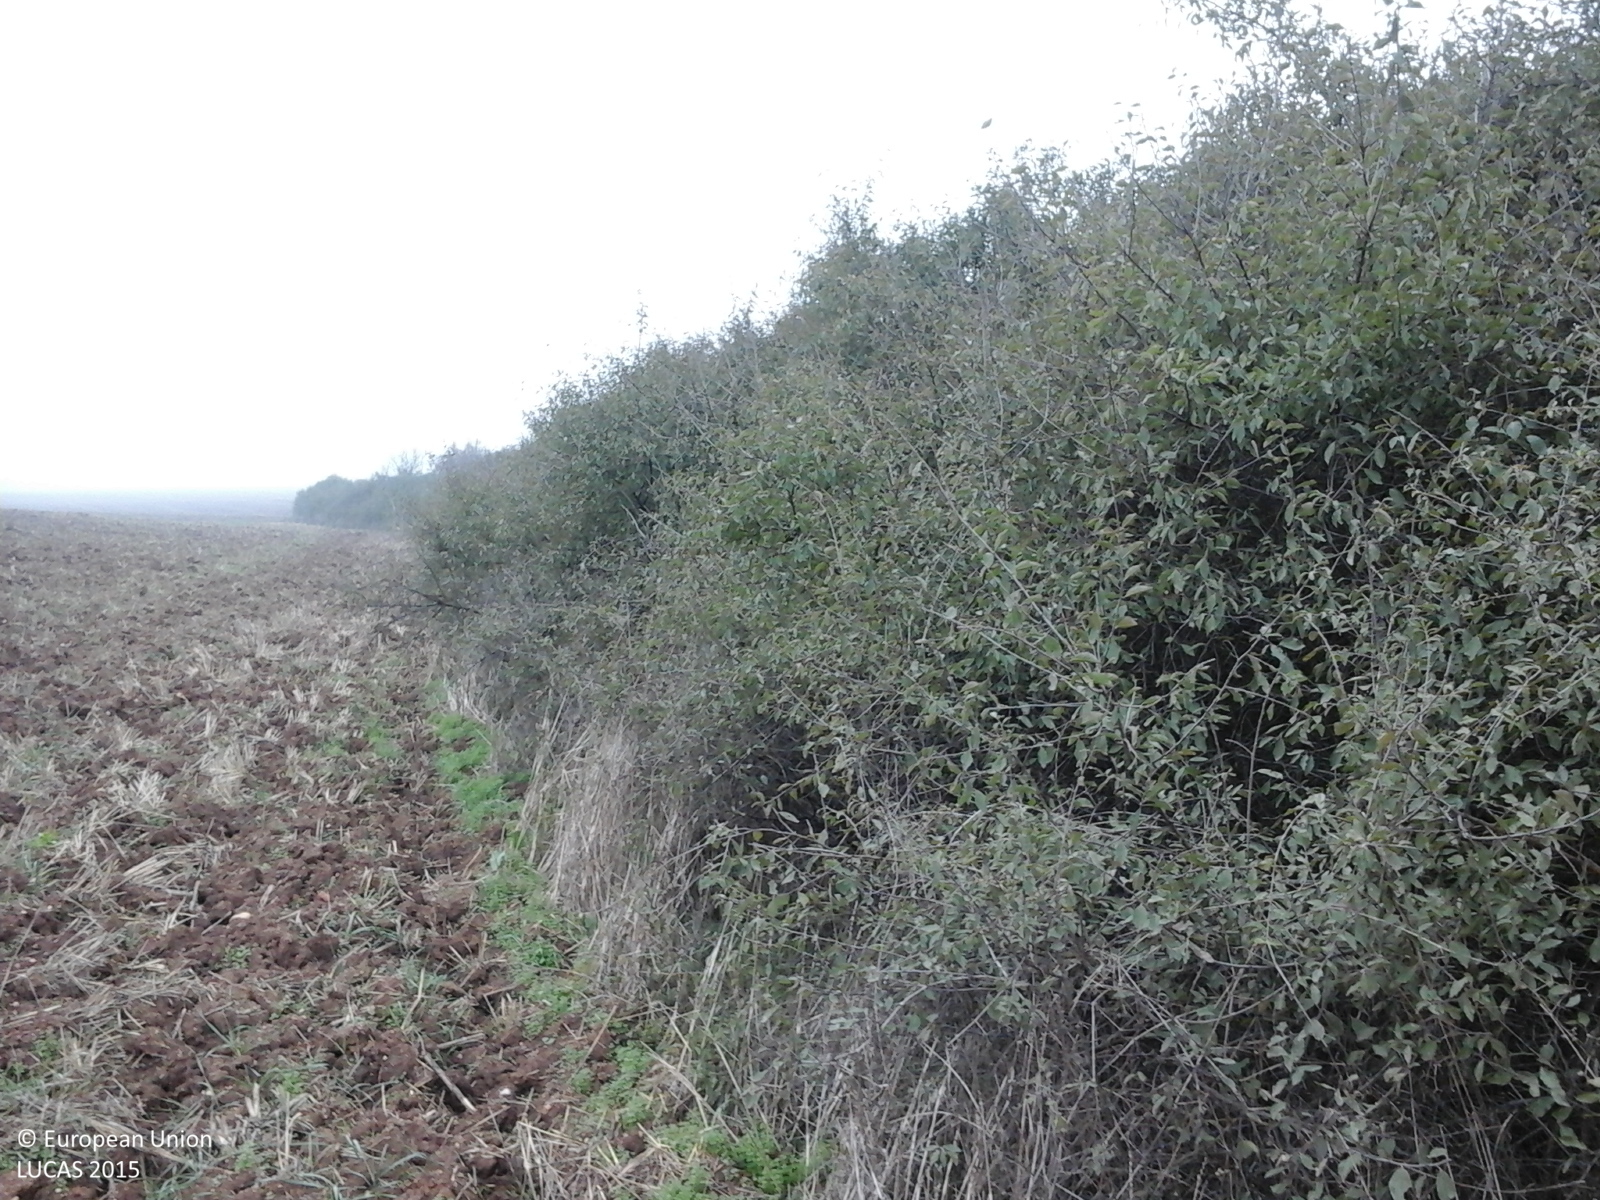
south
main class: Shrubland
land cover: Shrubland with sparse tree cover
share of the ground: > 75 %
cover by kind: shrubs 95 %, broadleaved forest trees 5 %
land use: Semi-natural and natural areas not in use
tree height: < 5 m
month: October
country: RO
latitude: 45.9110
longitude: 23.3528
